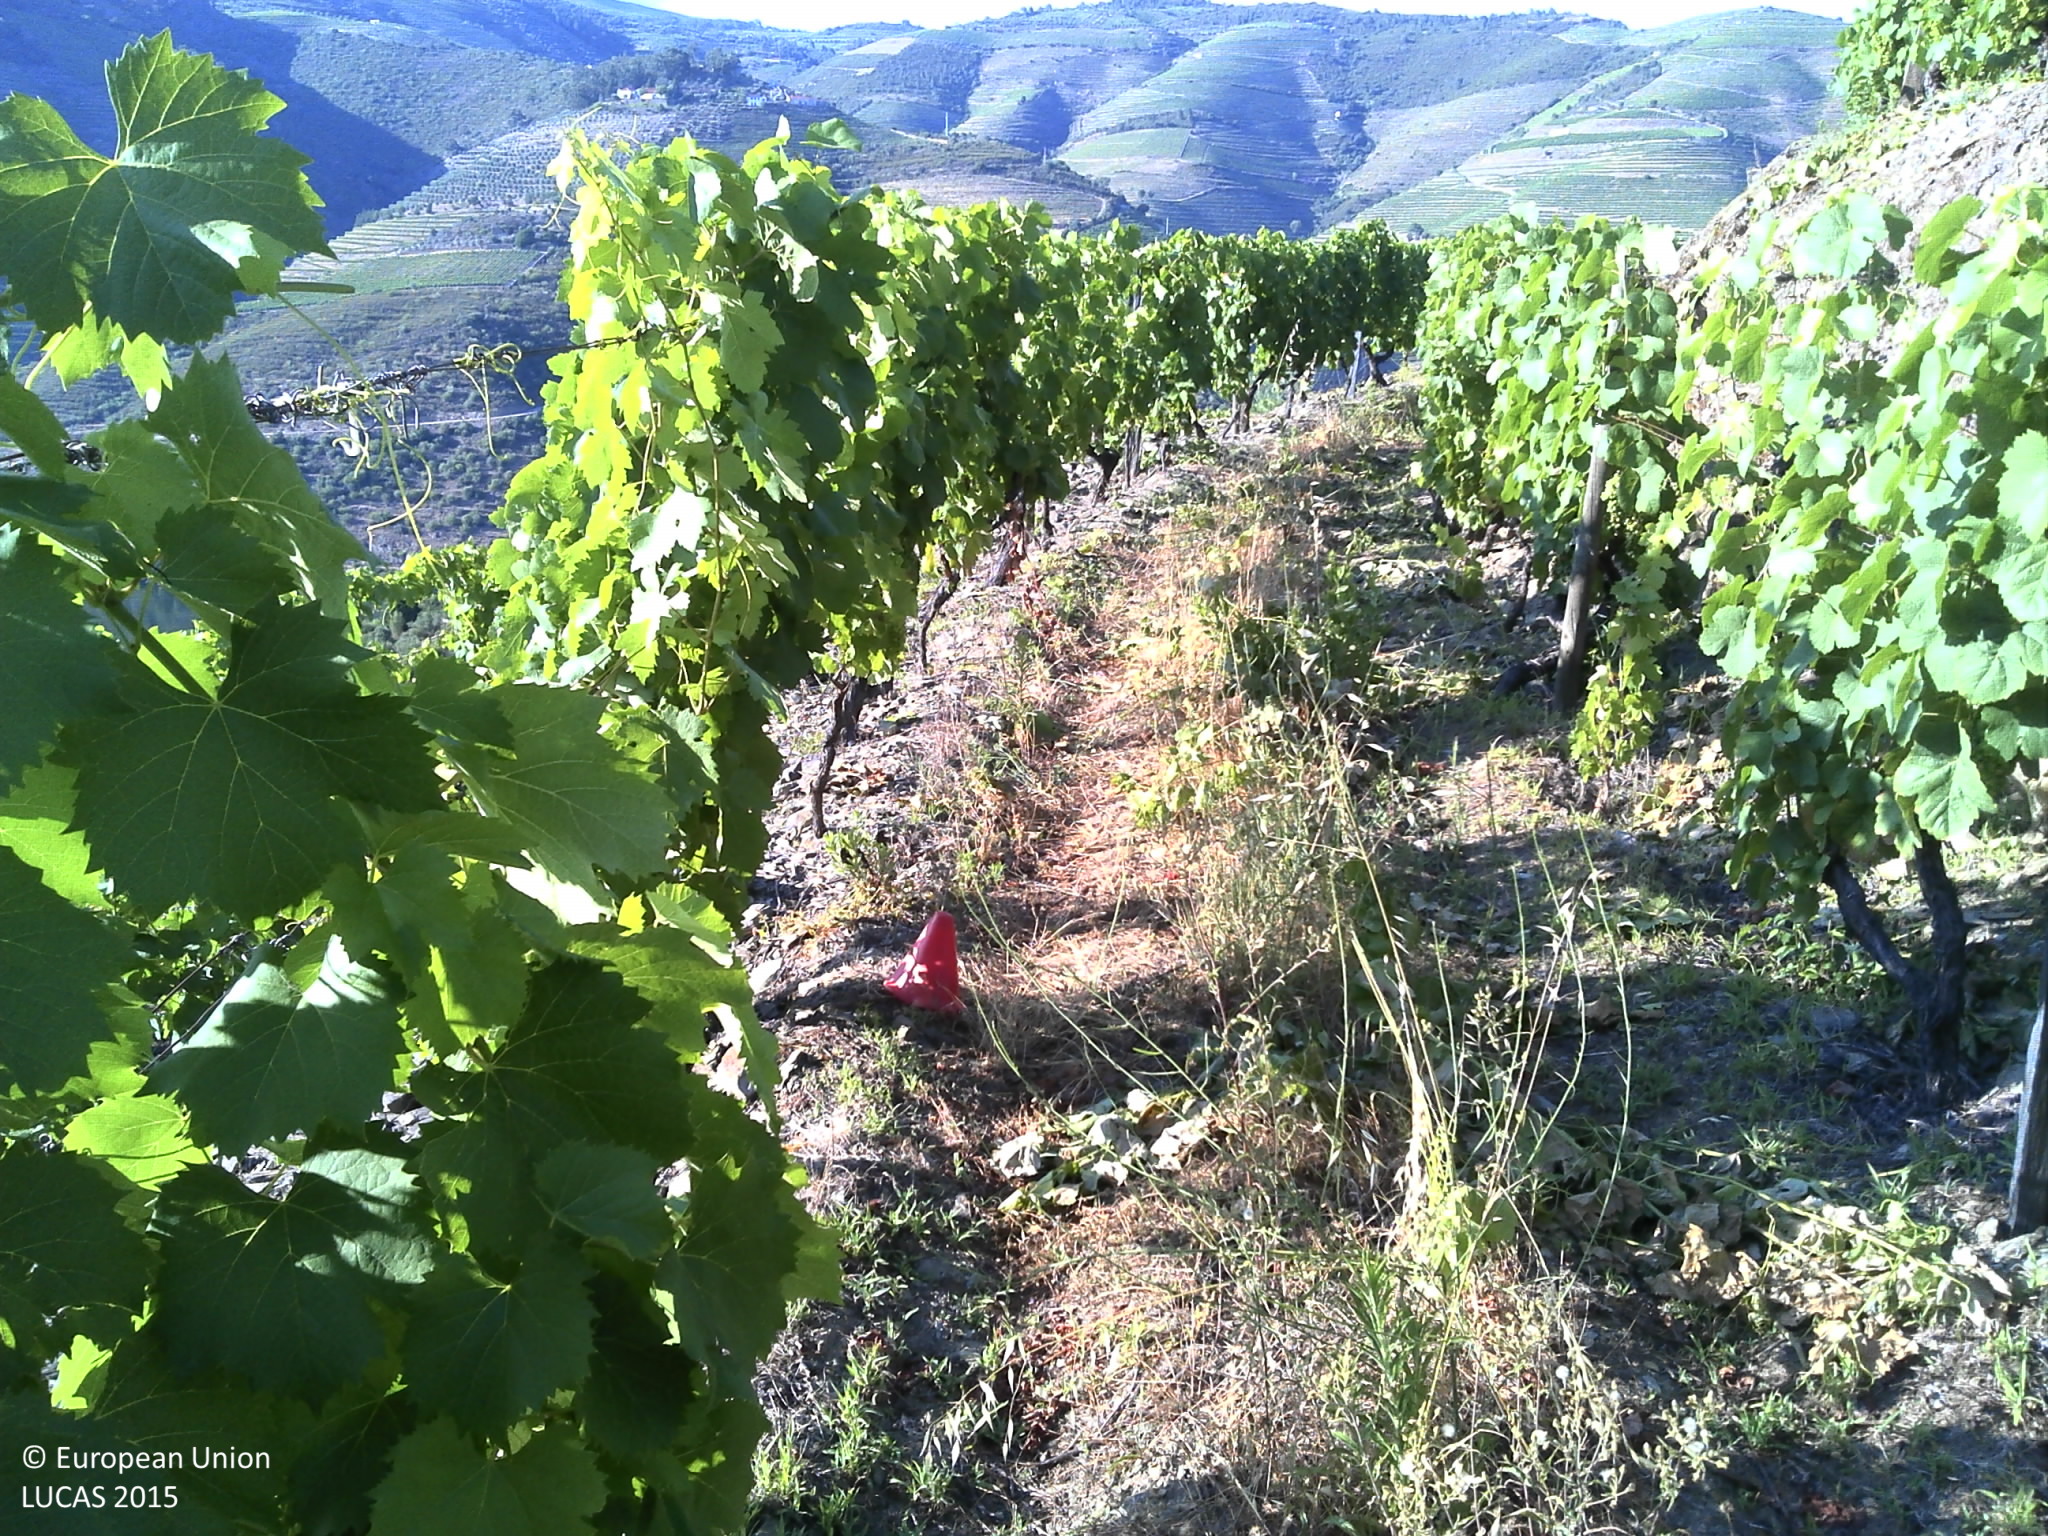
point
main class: Cropland
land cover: Vineyards
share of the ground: 10 - 25 %
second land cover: Grassland without tree/shrub cover
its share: 25 - 50 %
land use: Agriculture (excluding fallow land and kitchen gardens)
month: June
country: PT
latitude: 41.1529
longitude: -7.6053
